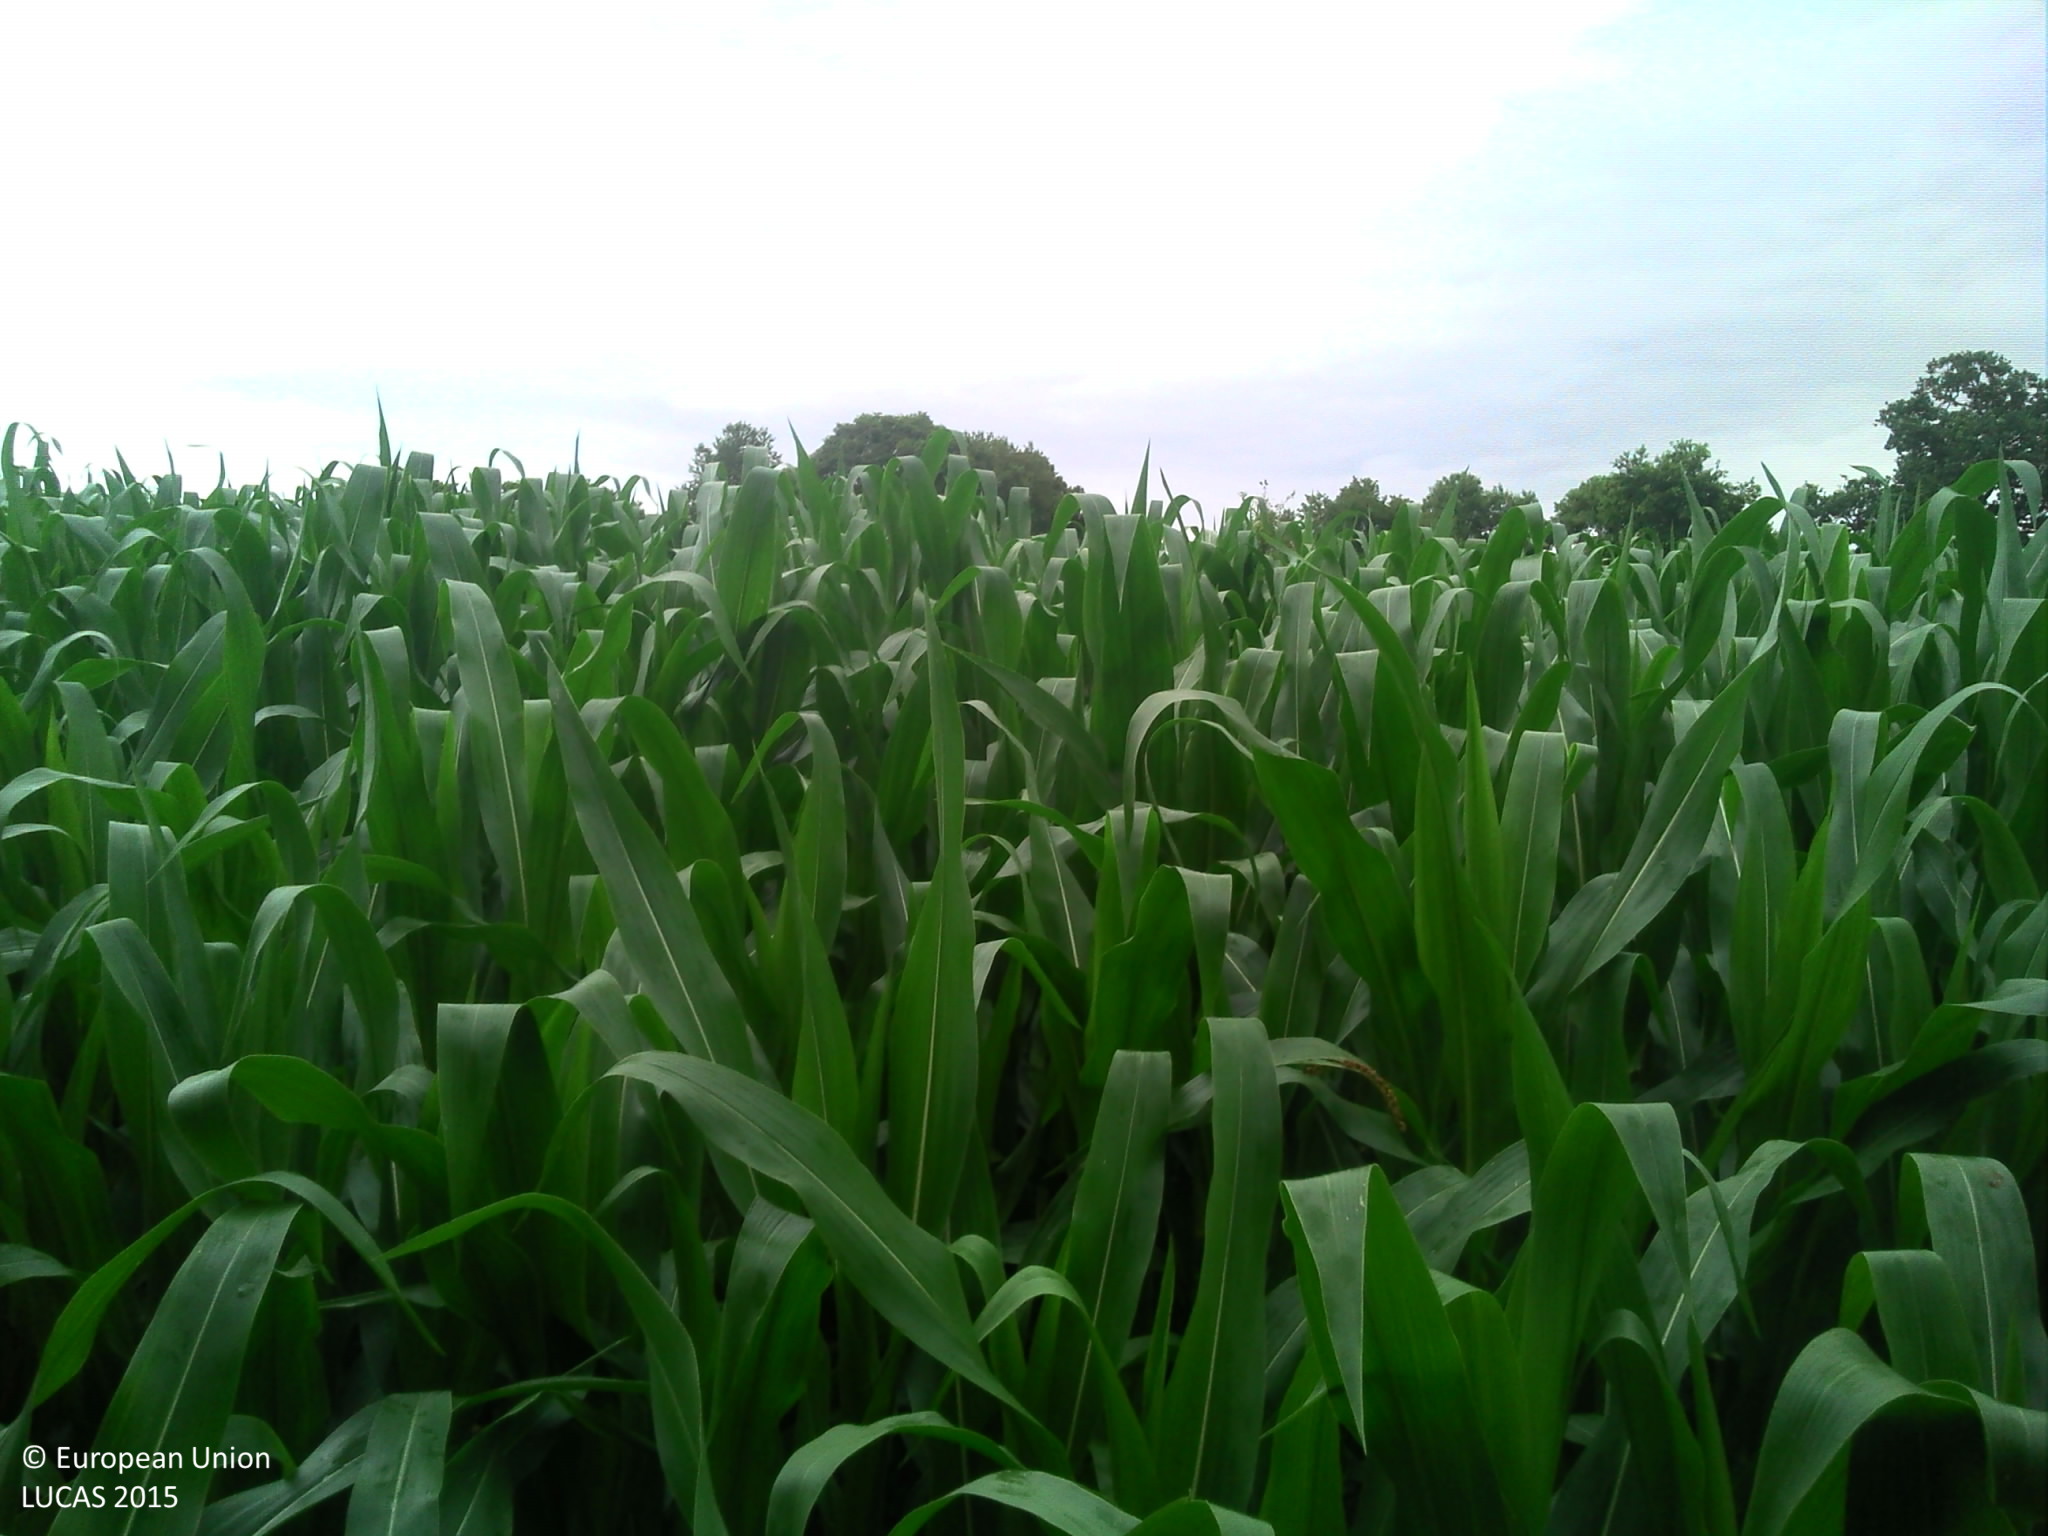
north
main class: Cropland
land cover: Maize
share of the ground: > 75 %
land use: Agriculture (excluding fallow land and kitchen gardens)
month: July
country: FR
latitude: 48.7738
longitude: -1.4087
